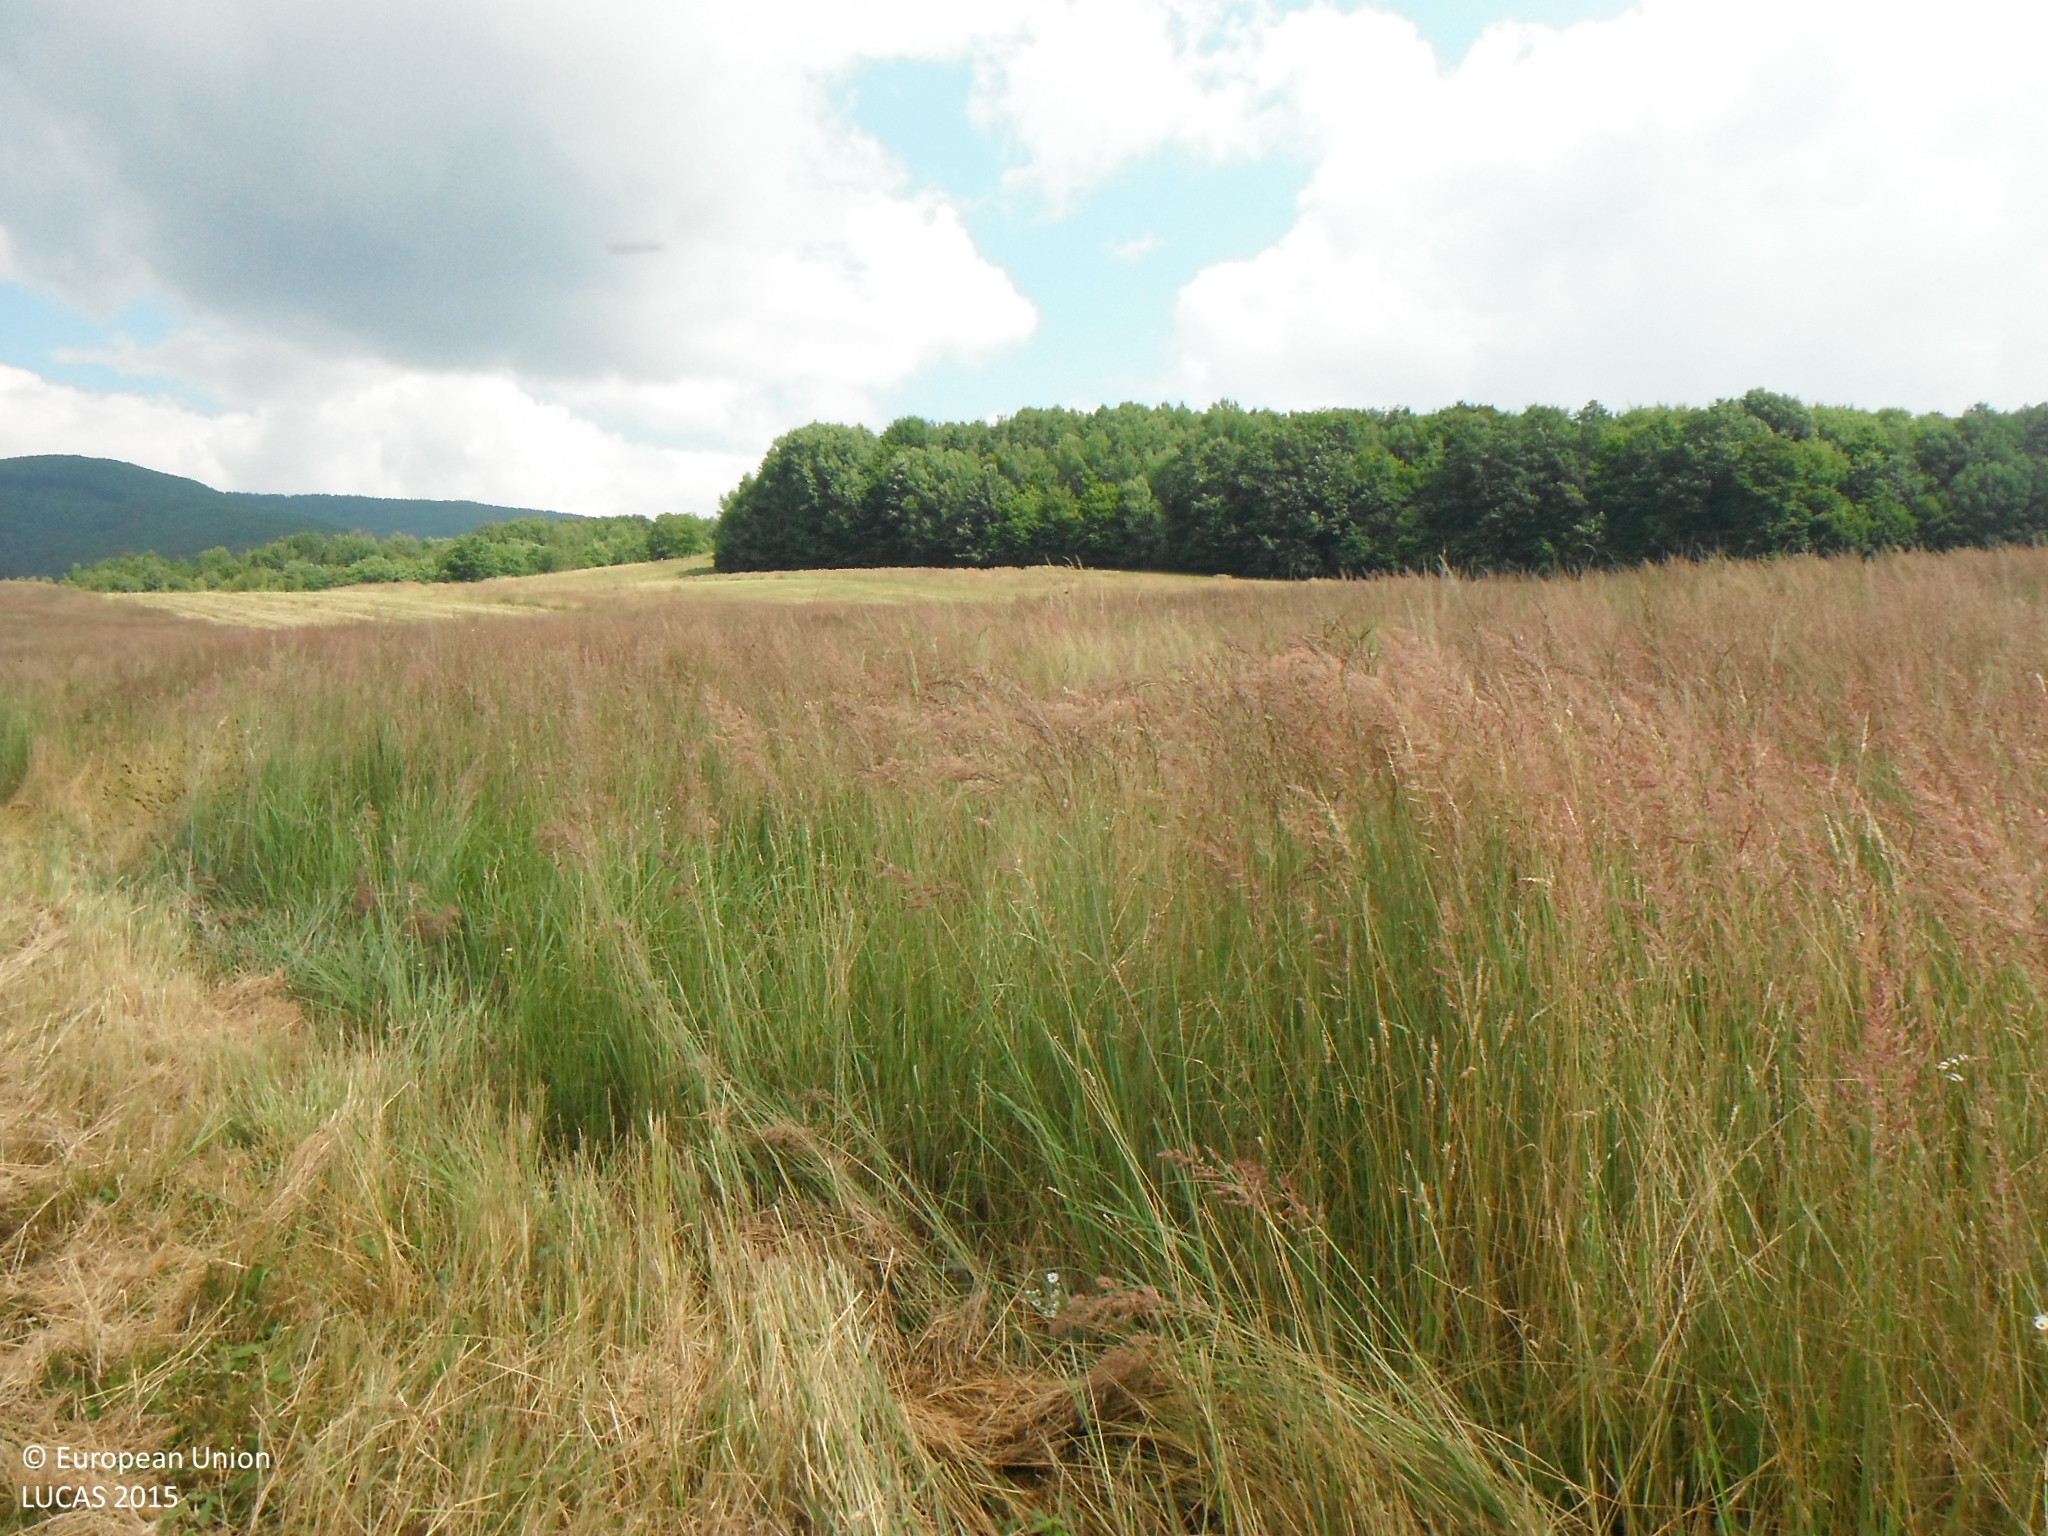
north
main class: Grassland
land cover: Grassland without tree/shrub cover
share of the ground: > 75 %
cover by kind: herbaceous plants 100 %
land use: Agriculture (excluding fallow land and kitchen gardens)
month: June
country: SK
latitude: 48.5178
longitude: 19.9255
